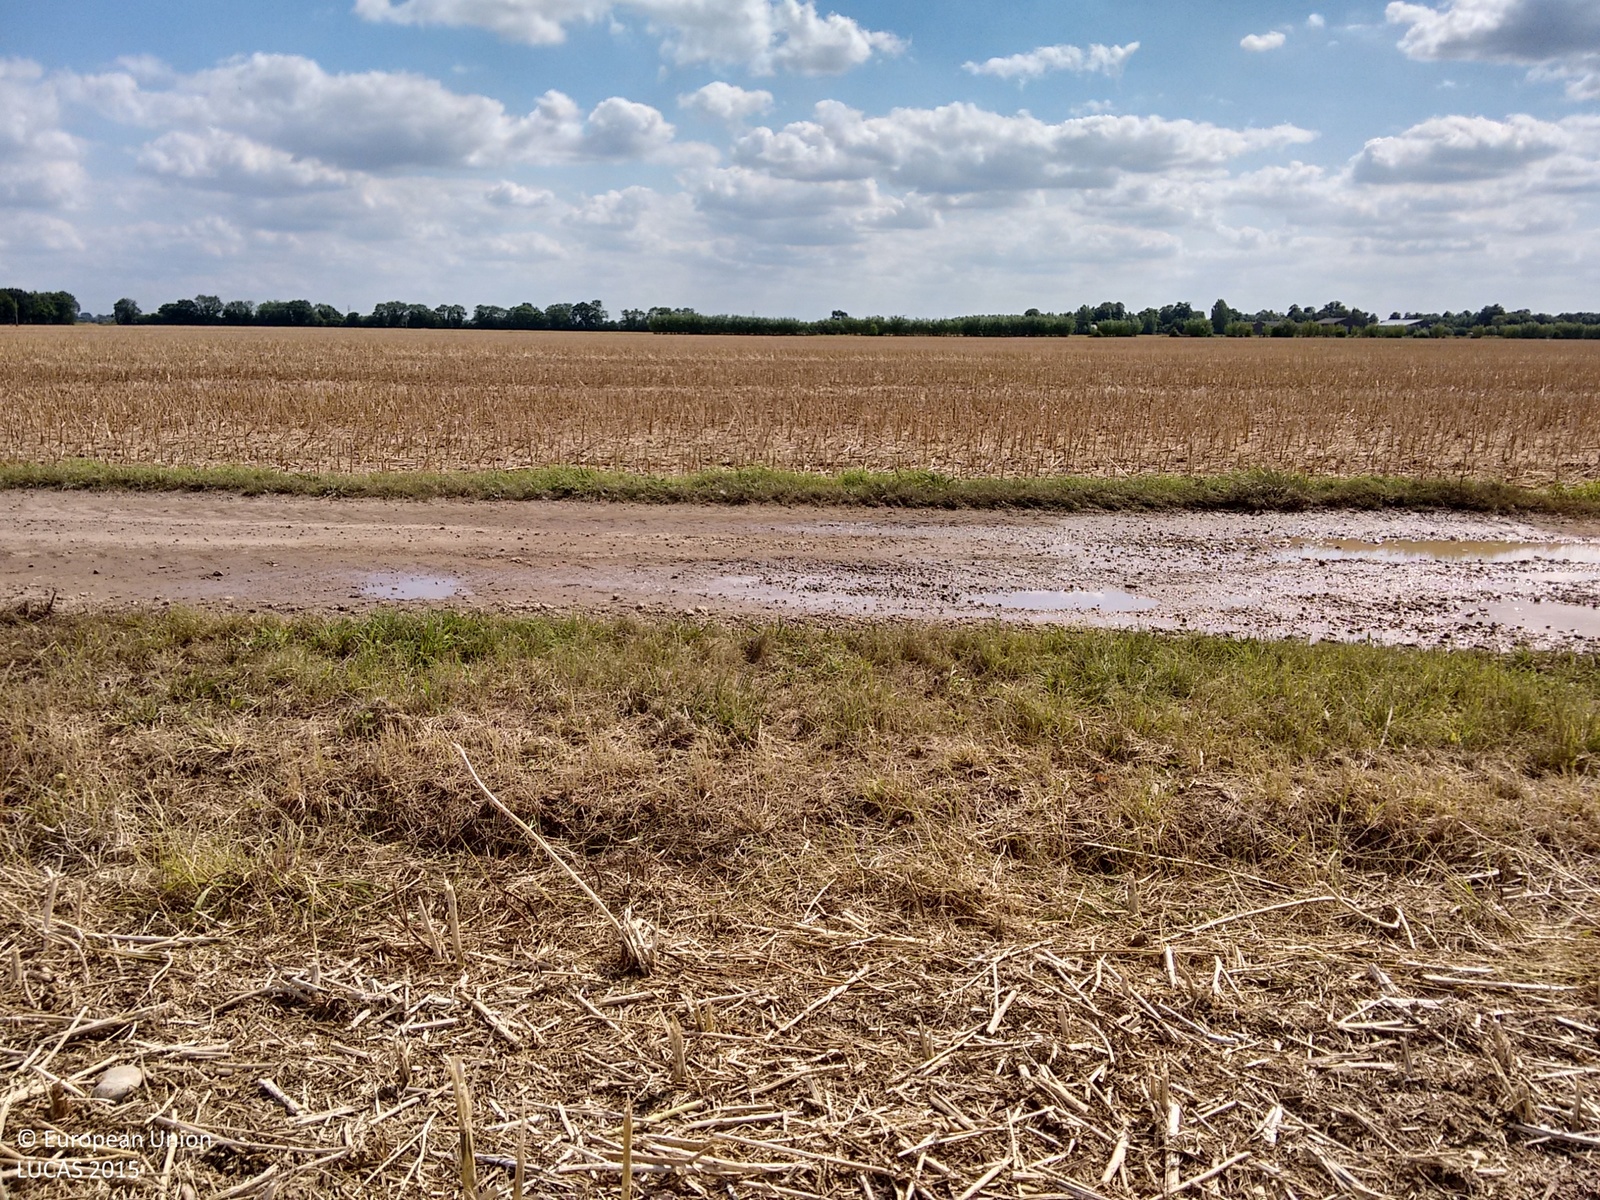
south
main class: Cropland
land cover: Rape and turnip rape
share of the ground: > 75 %
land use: Agriculture (excluding fallow land and kitchen gardens)
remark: Harvested field
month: July
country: GB
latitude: 52.7803
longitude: 0.3495
